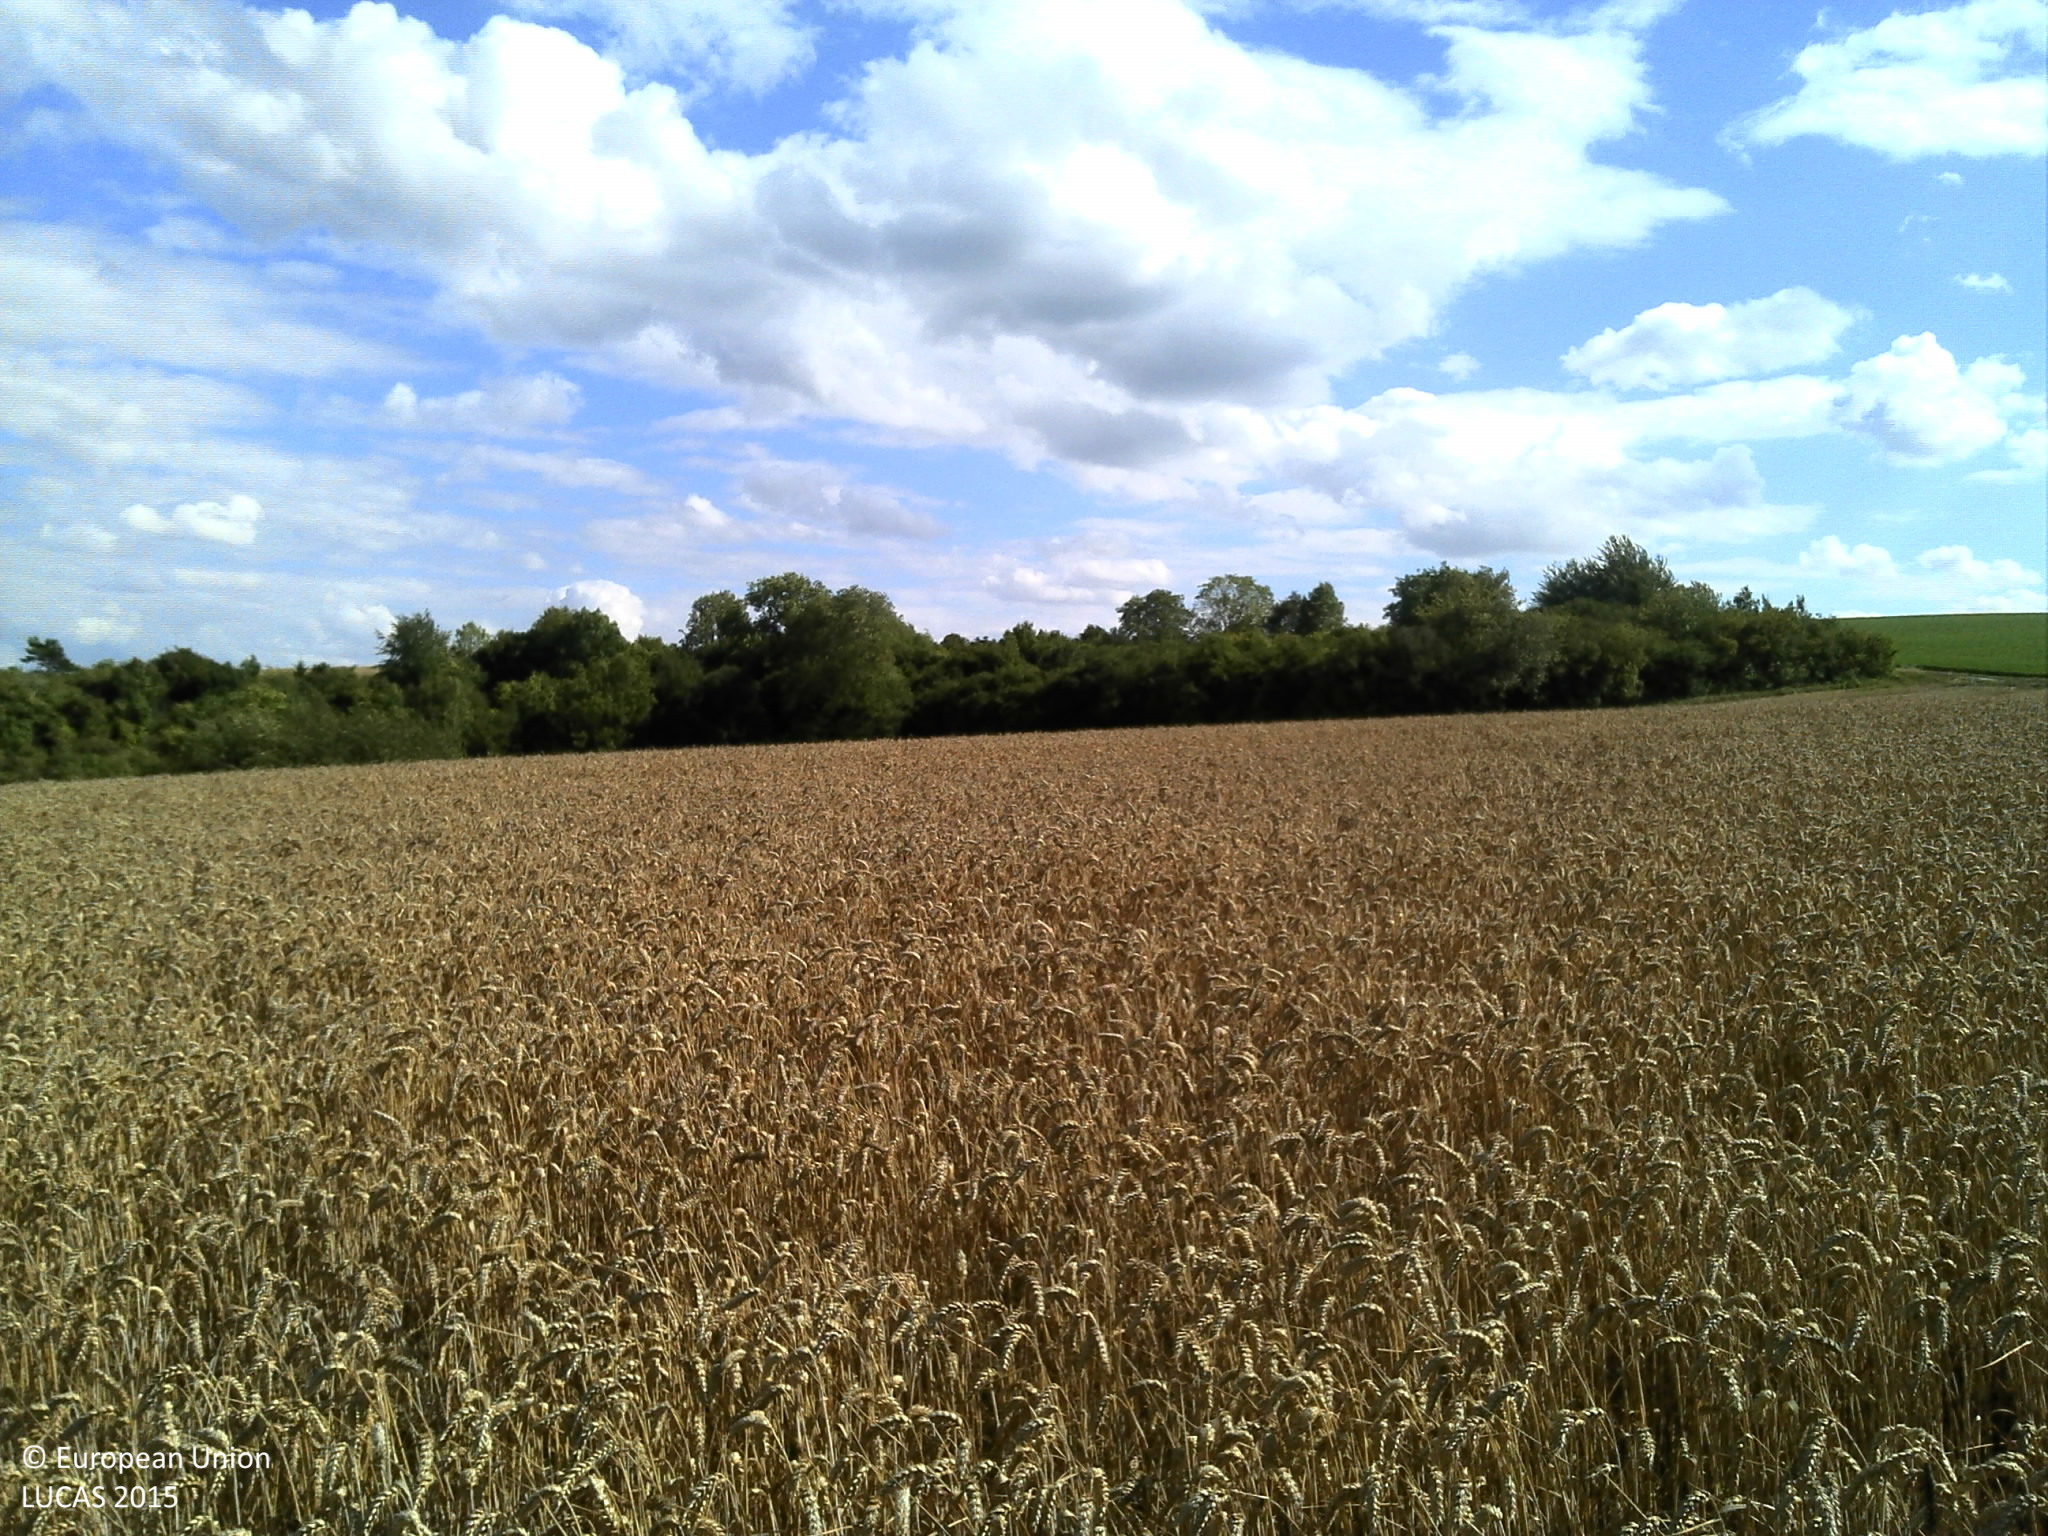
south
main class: Cropland
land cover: Common wheat
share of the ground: > 75 %
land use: Agriculture (excluding fallow land and kitchen gardens)
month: July
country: FR
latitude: 49.2657
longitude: 4.6511
